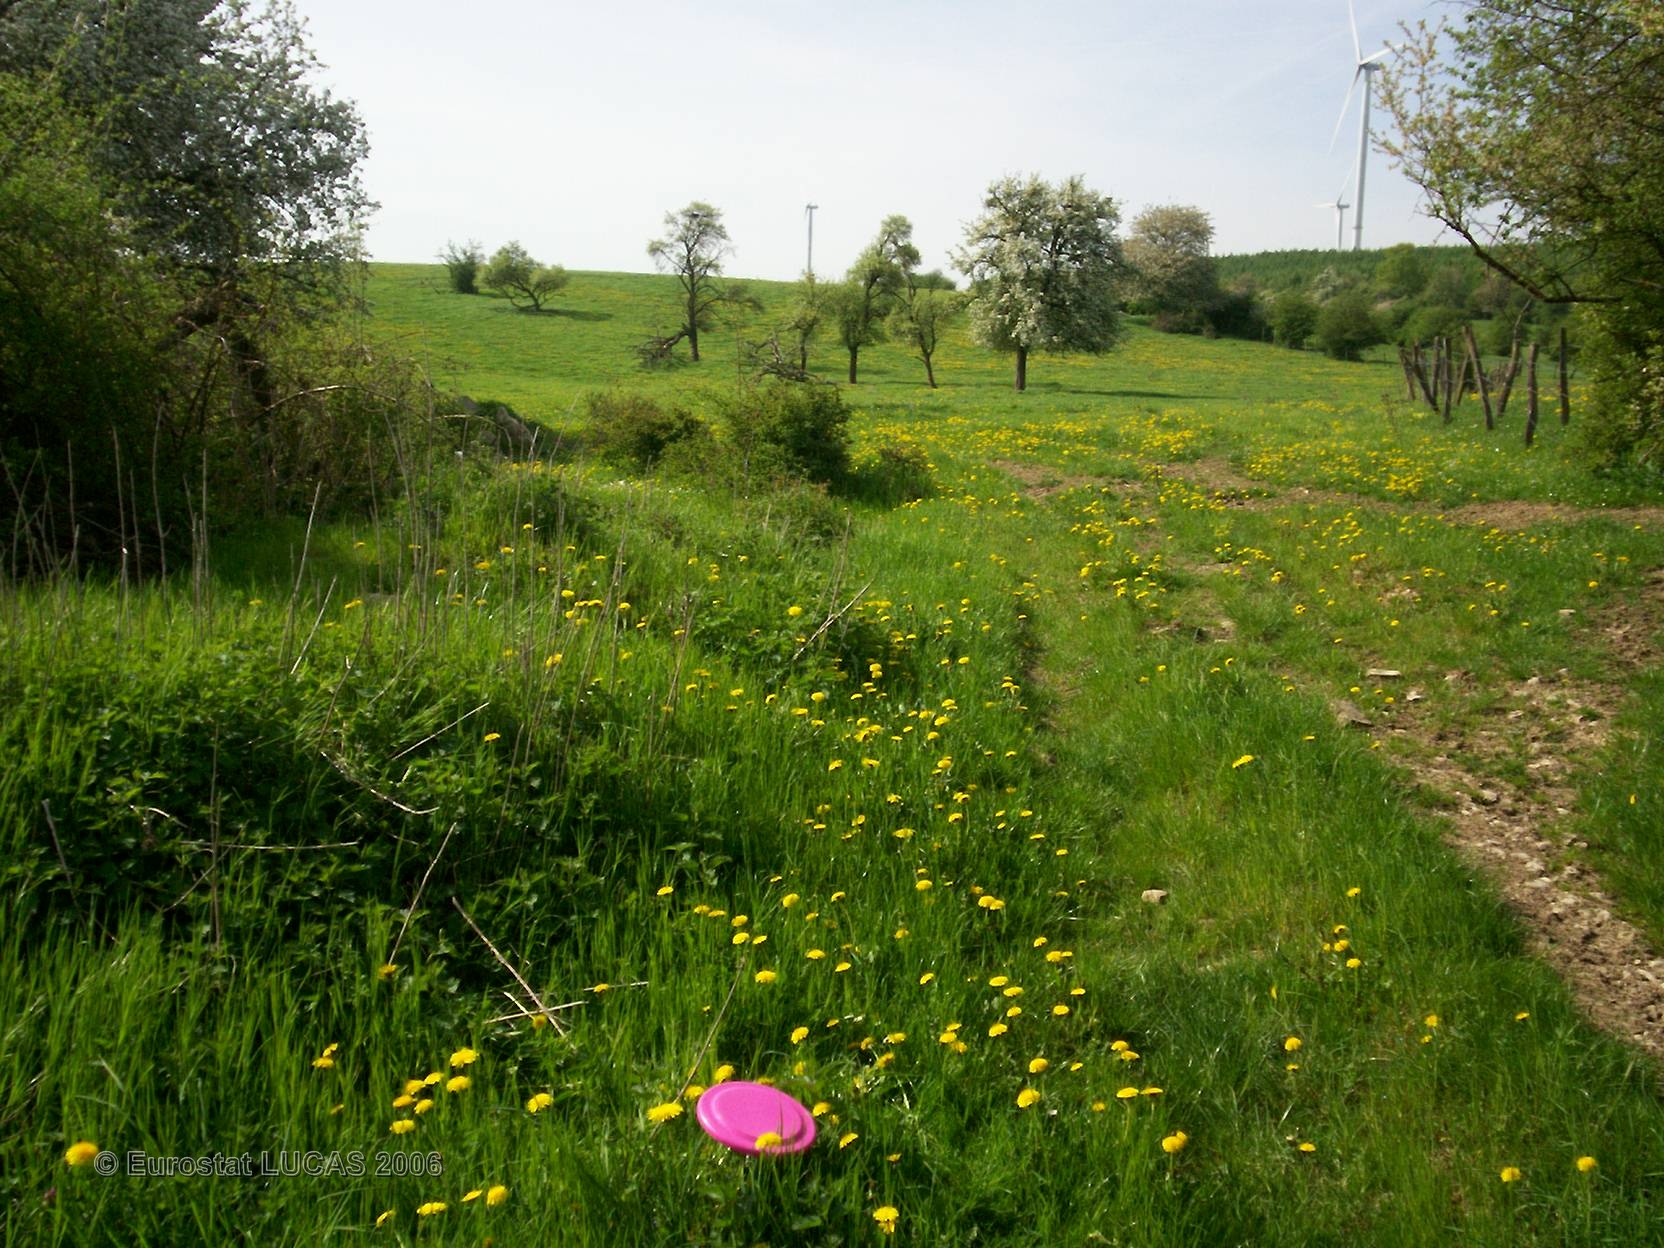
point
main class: Grassland
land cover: Grassland with sparse tree/shrub cover
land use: Unused
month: May
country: FR
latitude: 49.1594
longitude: 6.5307
